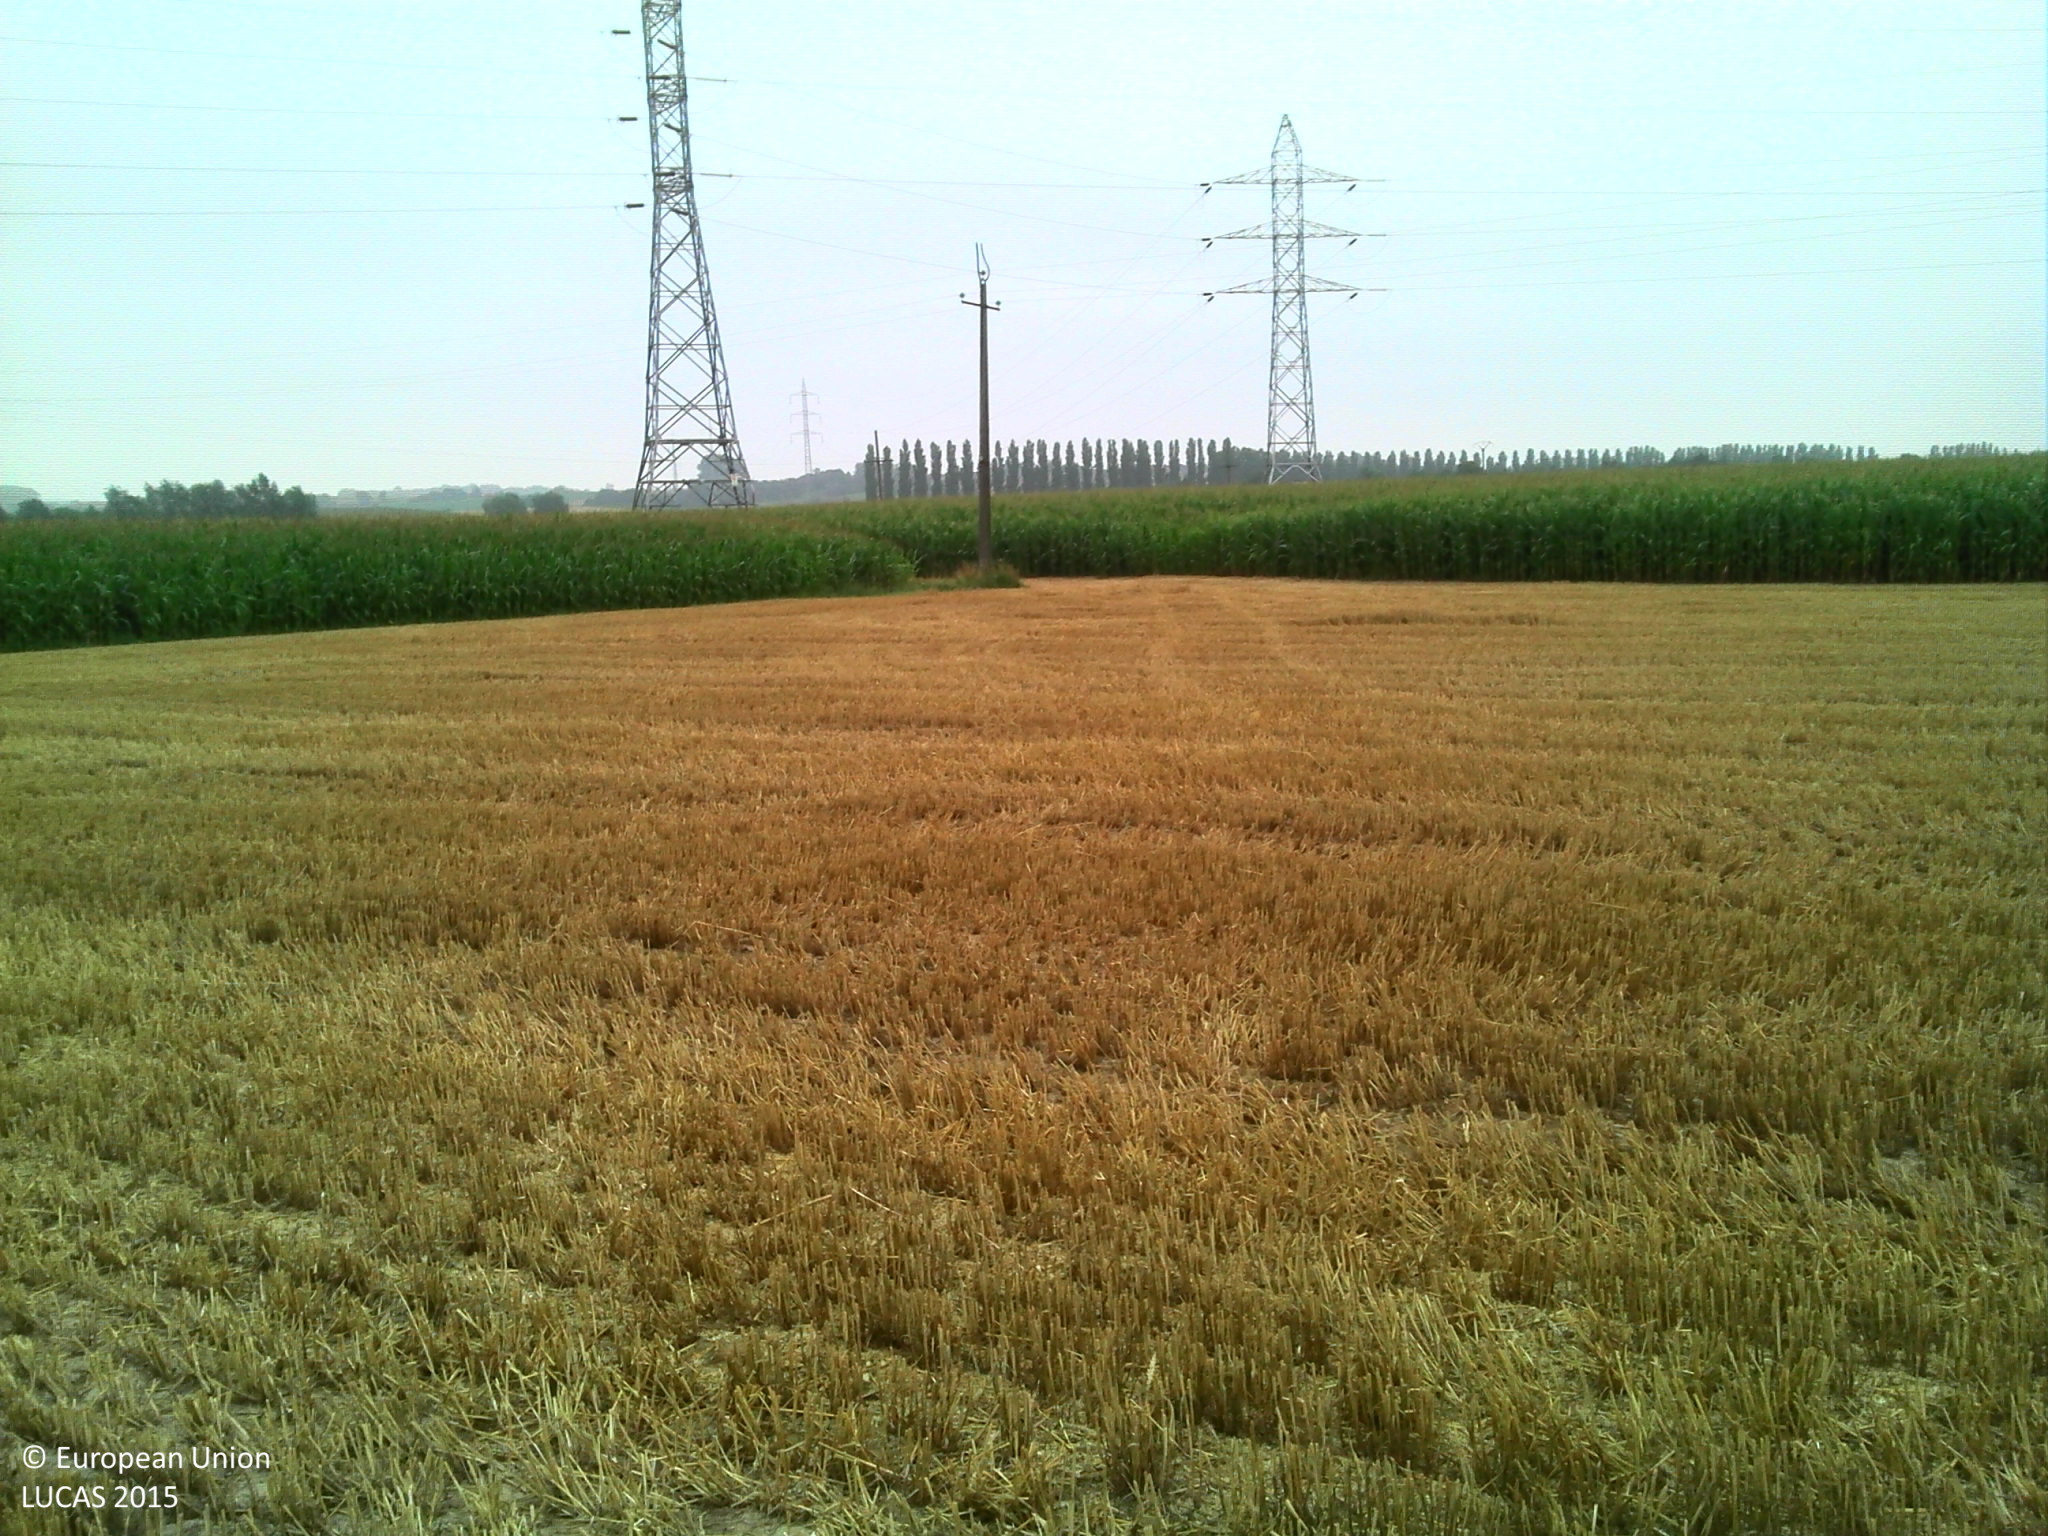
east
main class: Cropland
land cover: Common wheat
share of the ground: > 75 %
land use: Agriculture (excluding fallow land and kitchen gardens)
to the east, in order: Common wheat; Grass margins; Maize; Electric lines; Maize; Electric lines; Ditches and canals; Common wheat; Fences; Grassland without tree/shrub cover
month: August
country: BE
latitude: 50.6351
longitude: 3.5877
